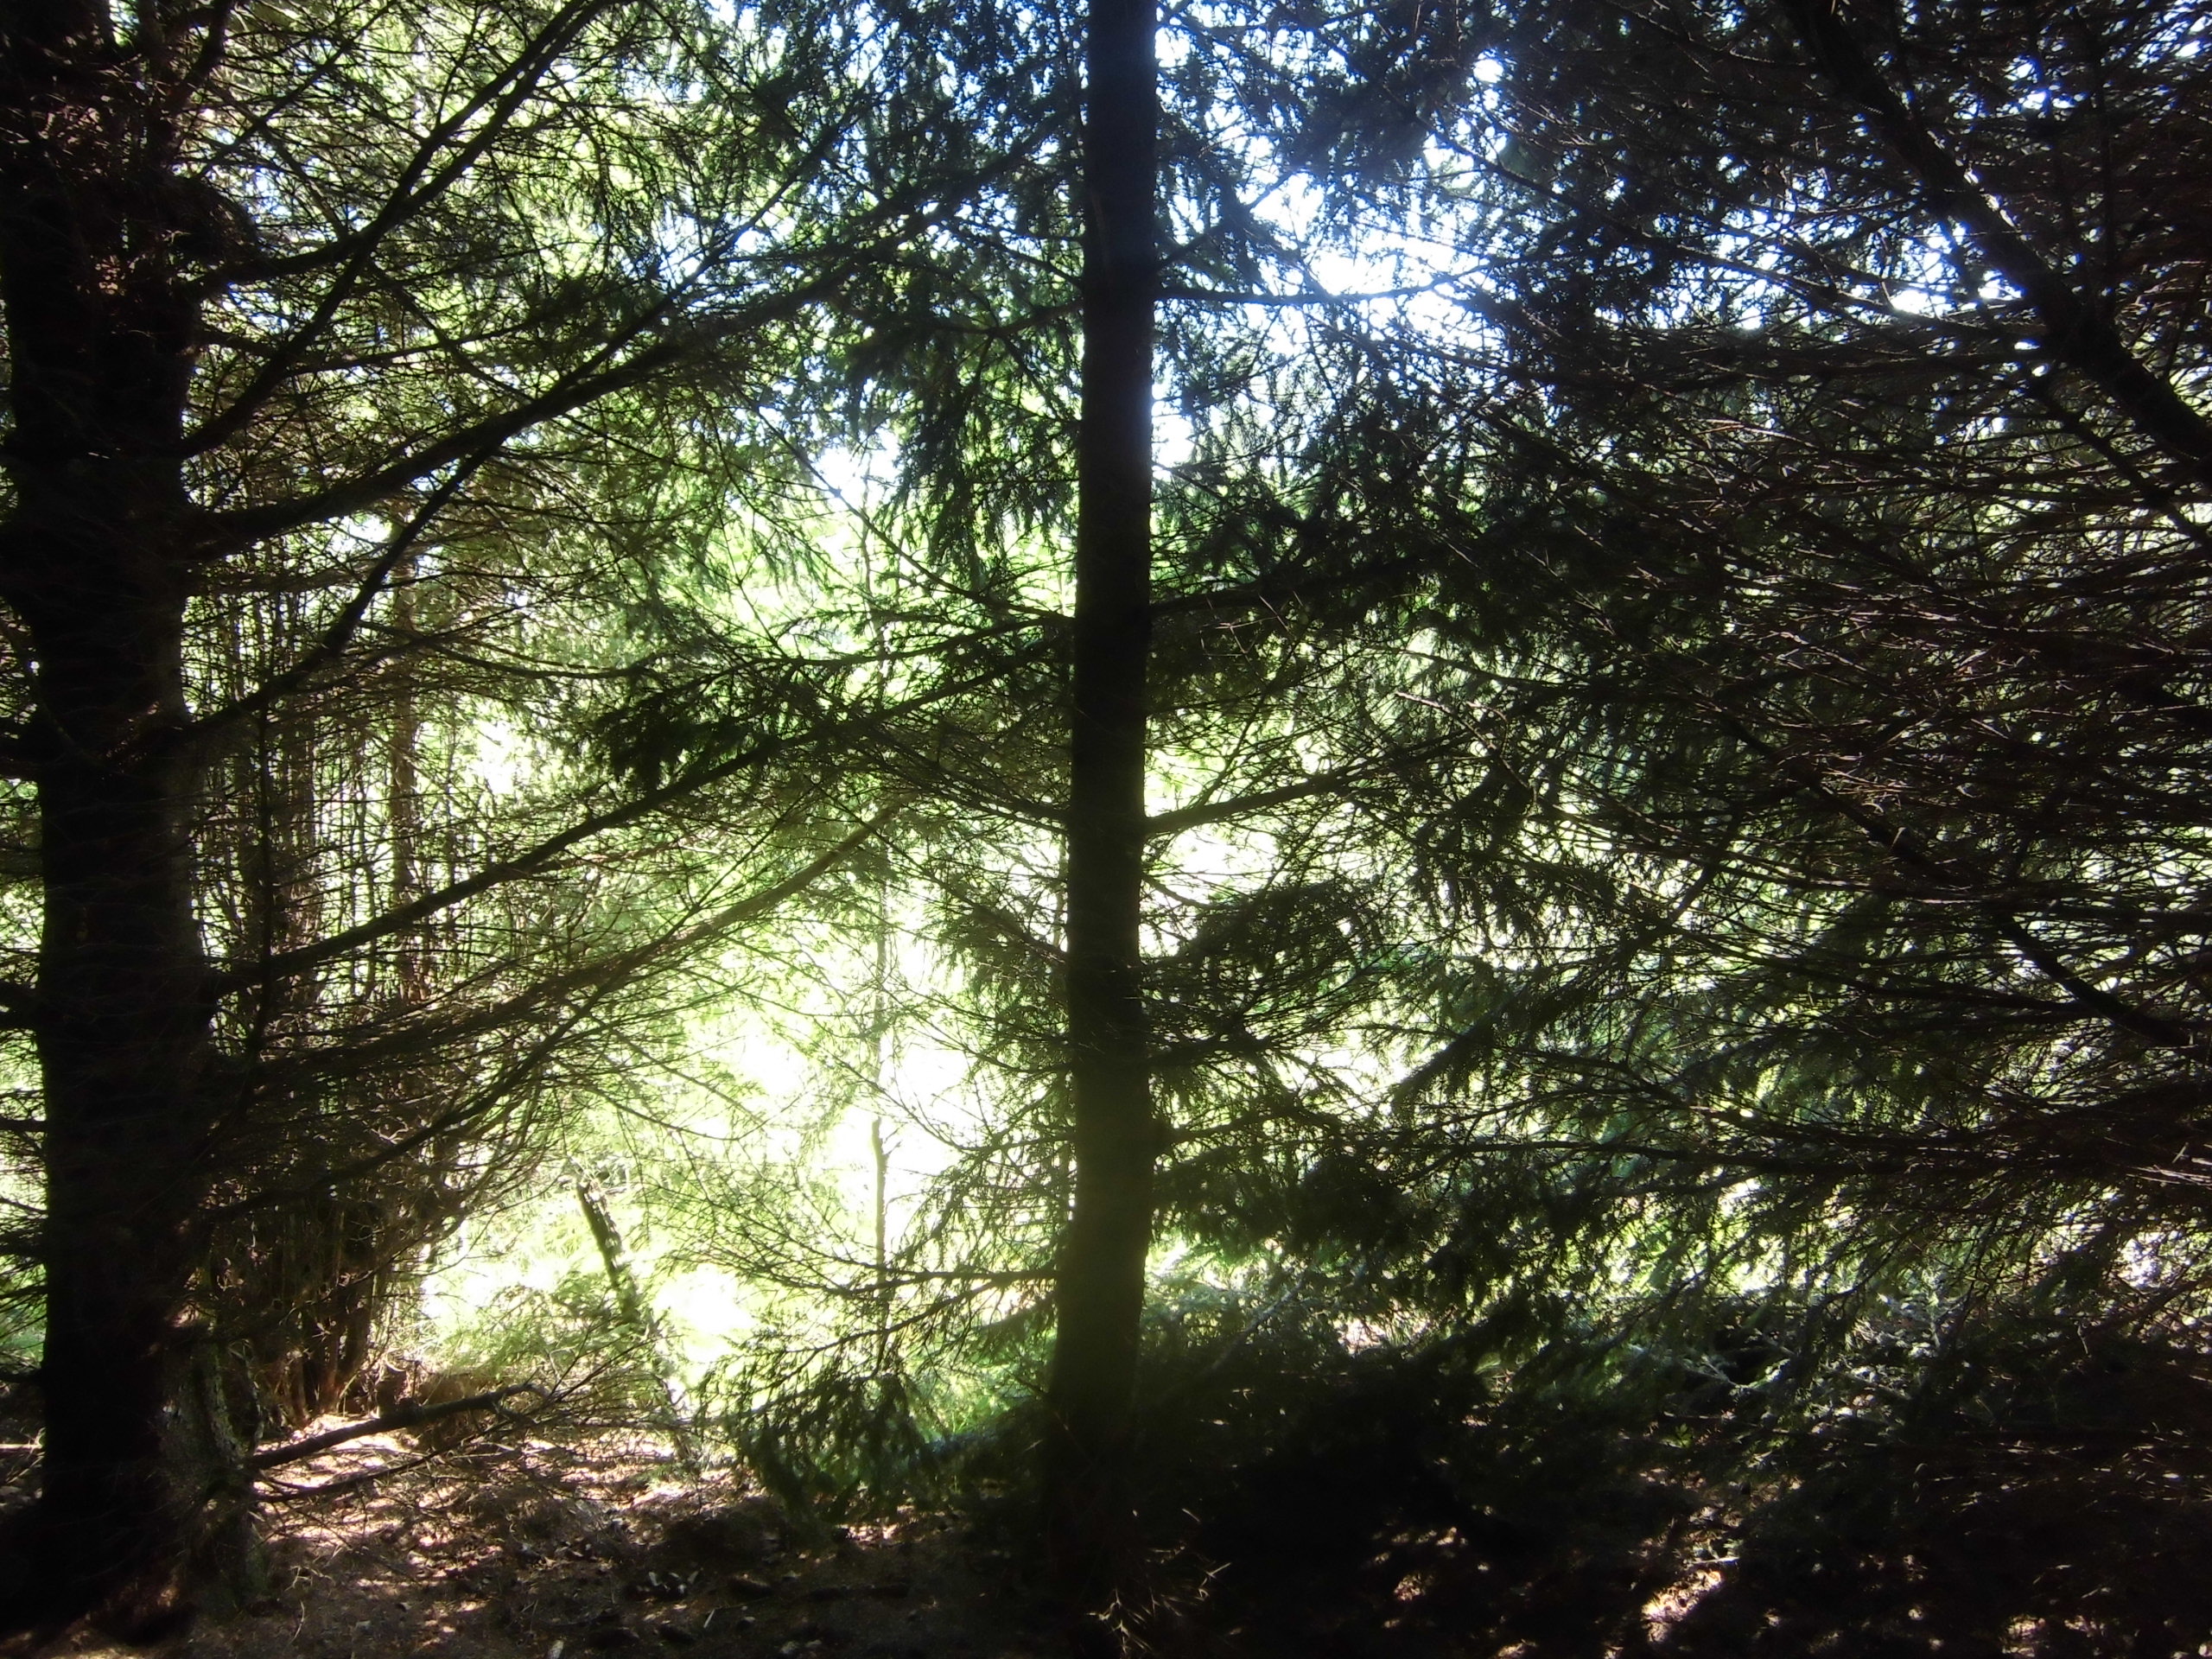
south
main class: Woodland
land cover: Spruce dominated coniferous woodland
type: boreal forest
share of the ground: > 75 %
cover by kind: coniferous forest trees 80 %, unconsolidated bare surface 15 %, herbaceous plants 5 %
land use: Forestry
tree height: > 5 m
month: July
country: SE
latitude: 57.1608
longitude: 15.2716
